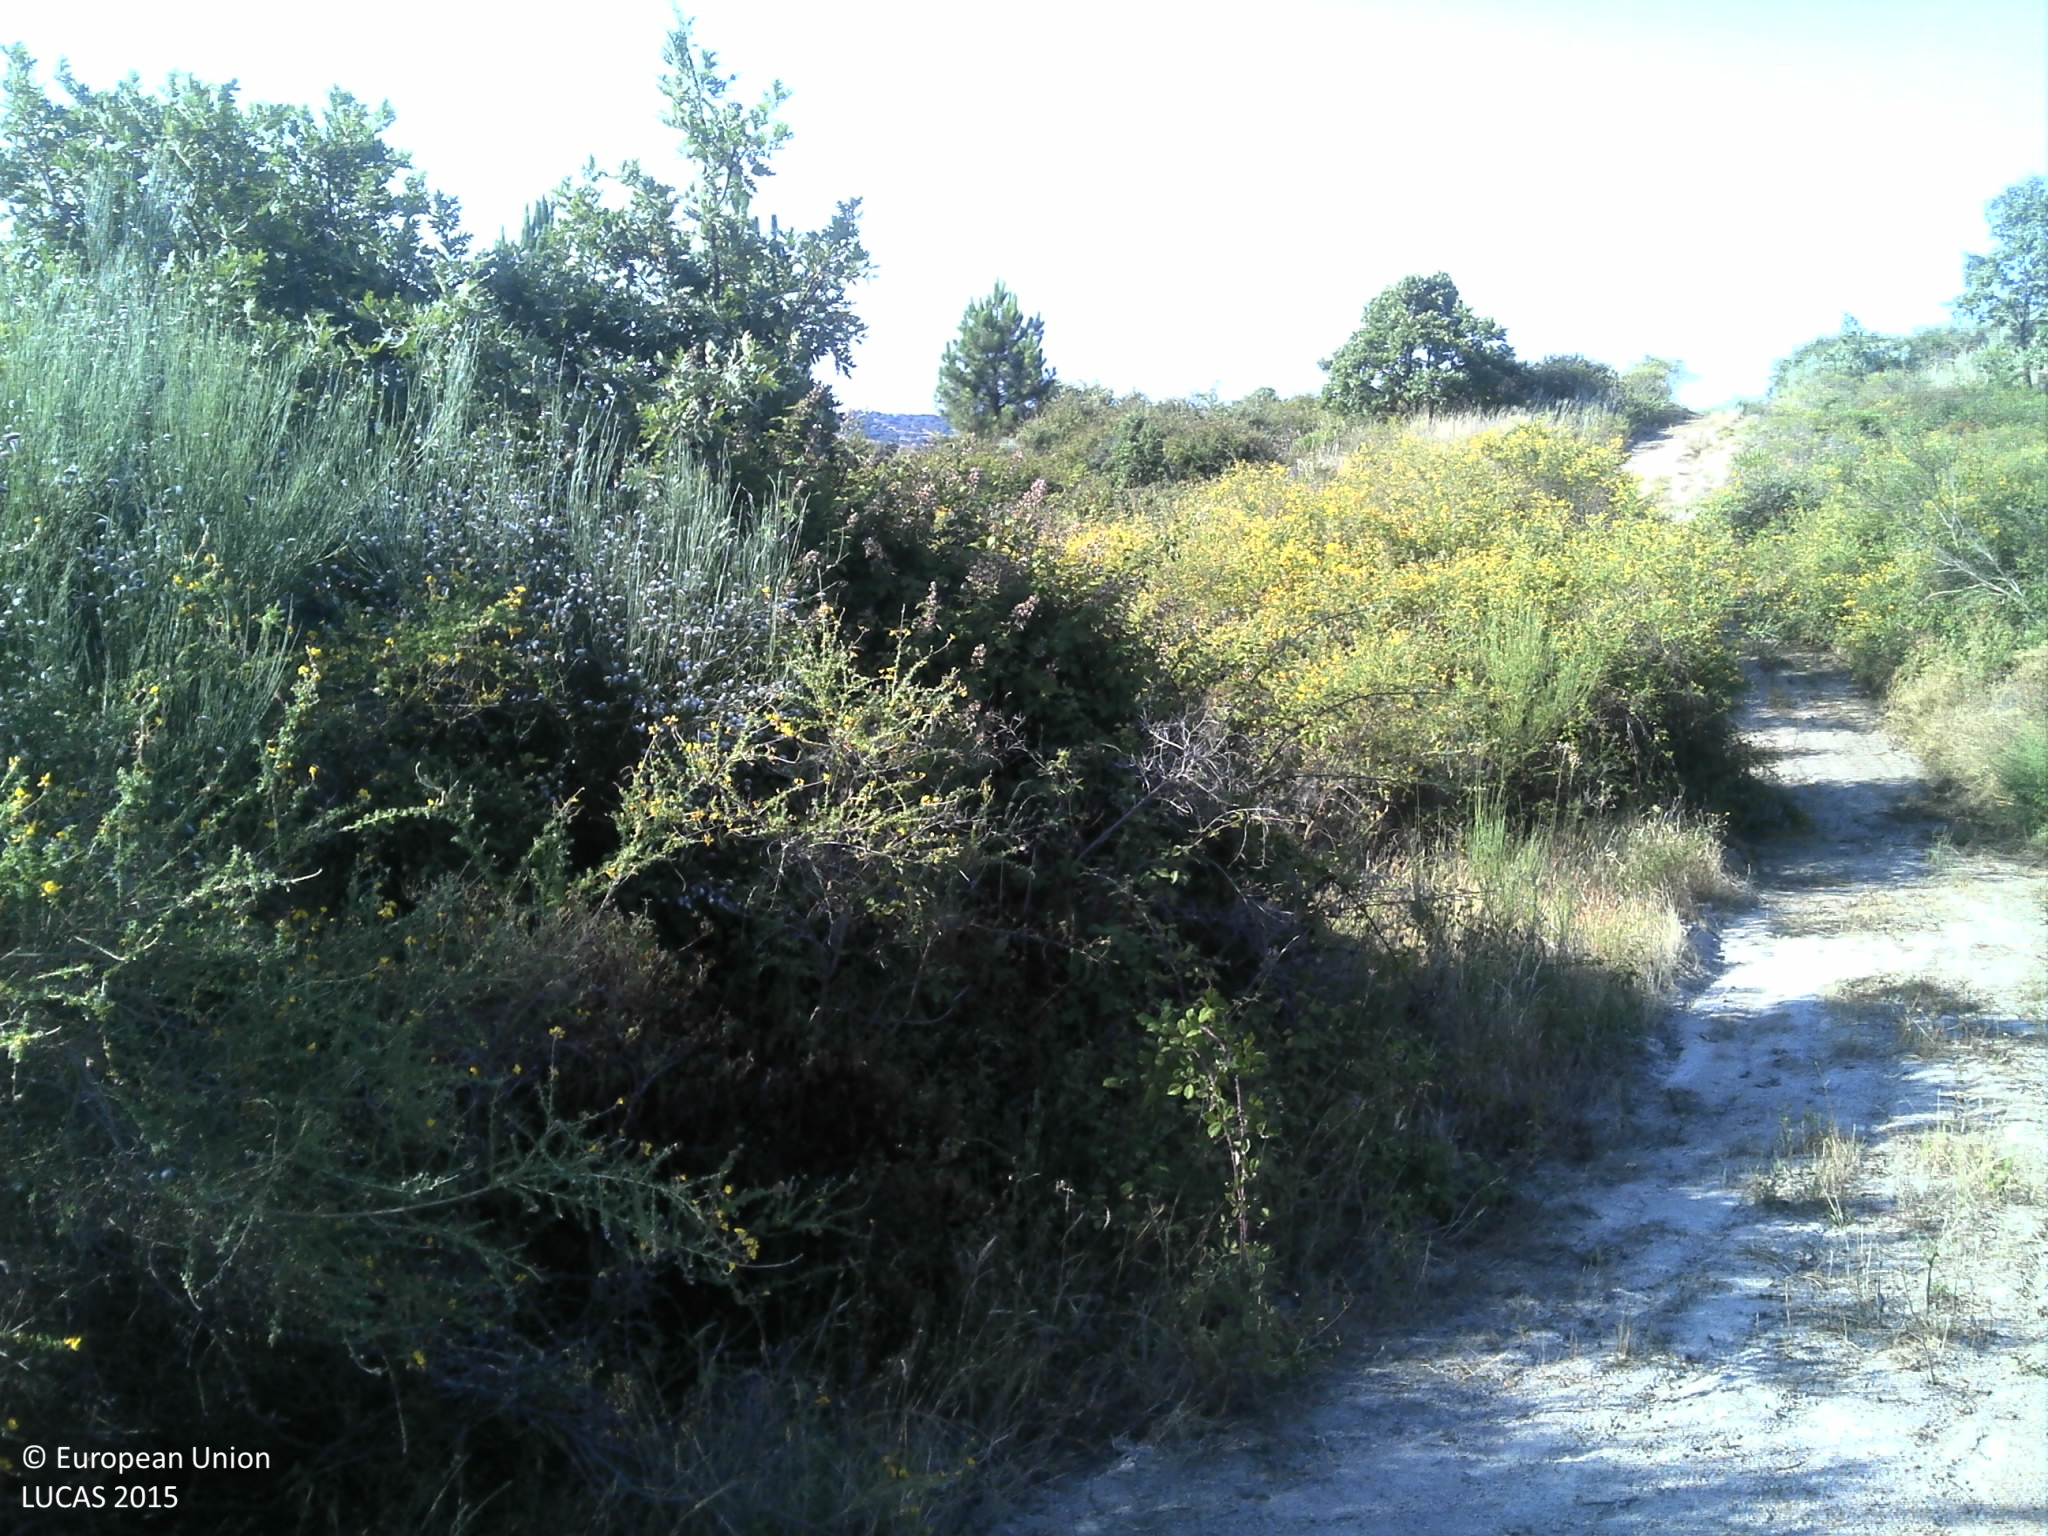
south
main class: Shrubland
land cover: Shrubland with sparse tree cover
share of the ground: 50 - 75 %
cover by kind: shrubs 70 %, herbaceous plants 15 %, coniferous forest trees 5 %, unconsolidated bare surface 5 %
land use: Semi-natural and natural areas not in use
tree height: < 5 m
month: June
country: PT
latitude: 40.0849
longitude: -7.1836
